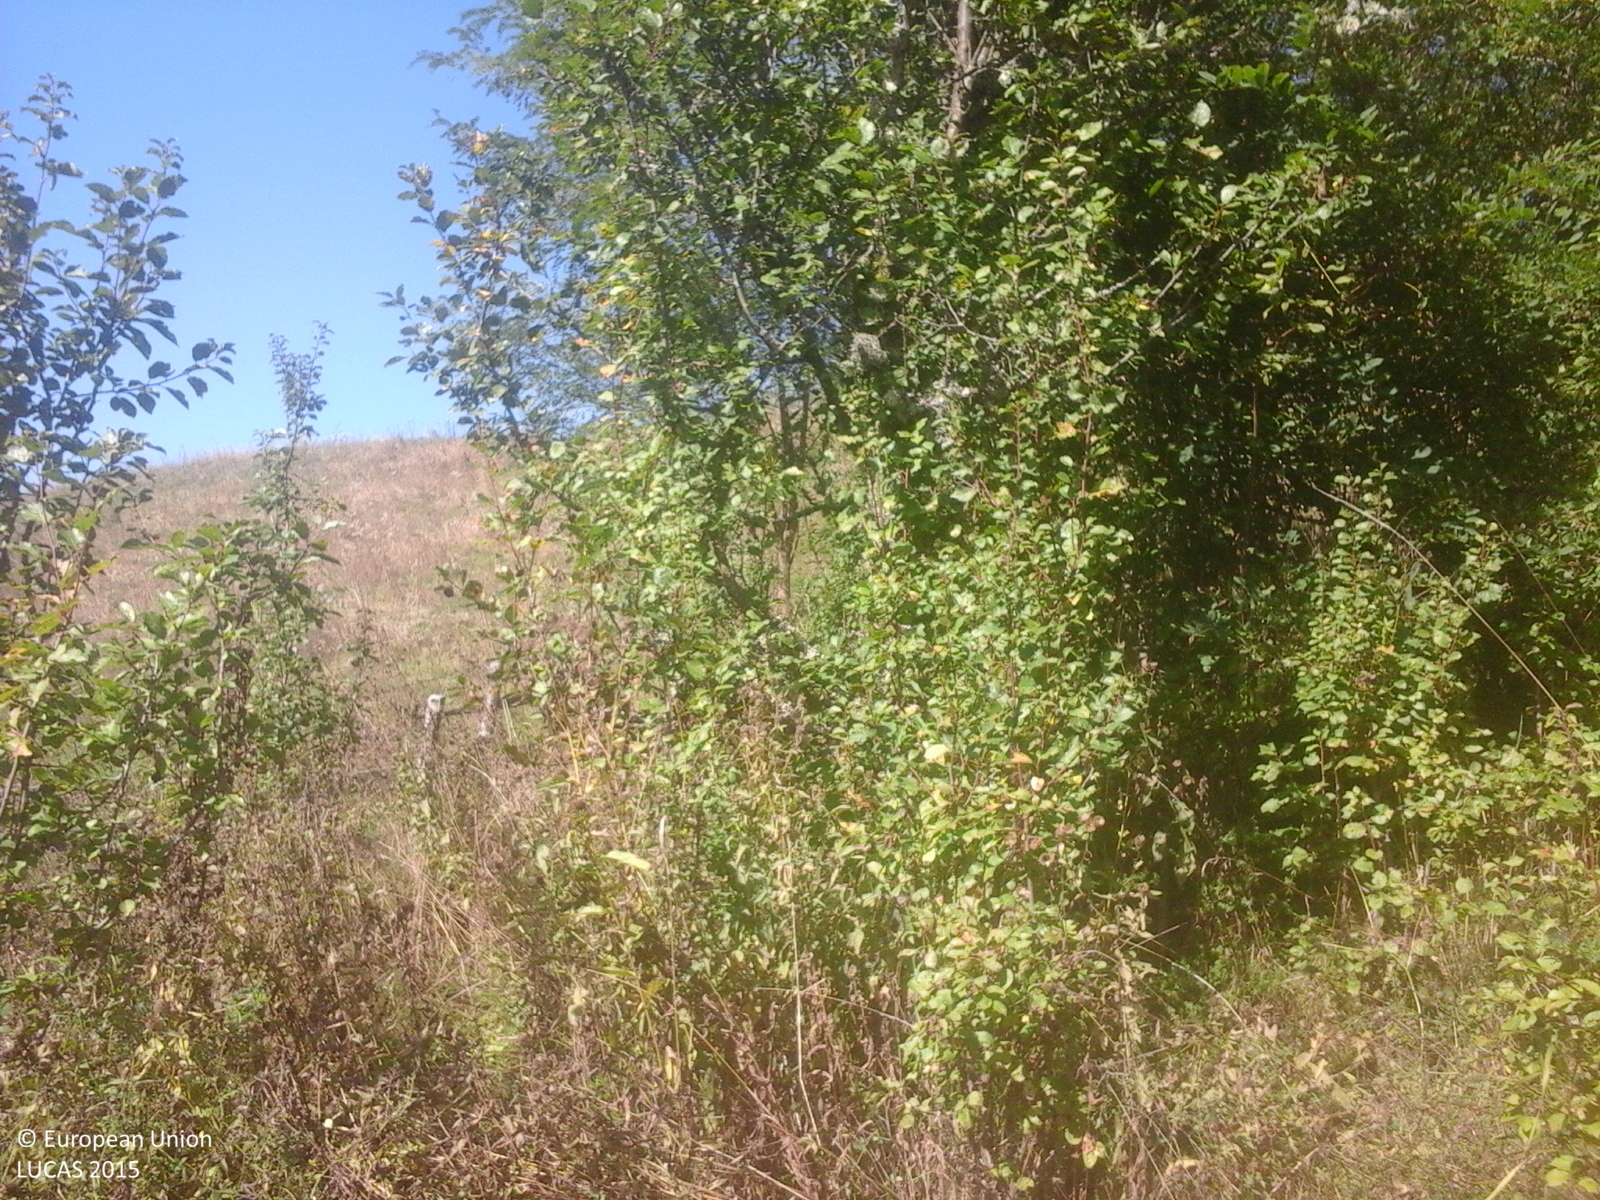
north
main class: Grassland
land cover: Grassland with sparse tree/shrub cover
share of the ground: > 75 %
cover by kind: herbaceous plants 85 %, shrubs 10 %, broadleaved forest trees 5 %
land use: Semi-natural and natural areas not in use
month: October
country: RO
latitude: 46.4105
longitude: 23.0026
